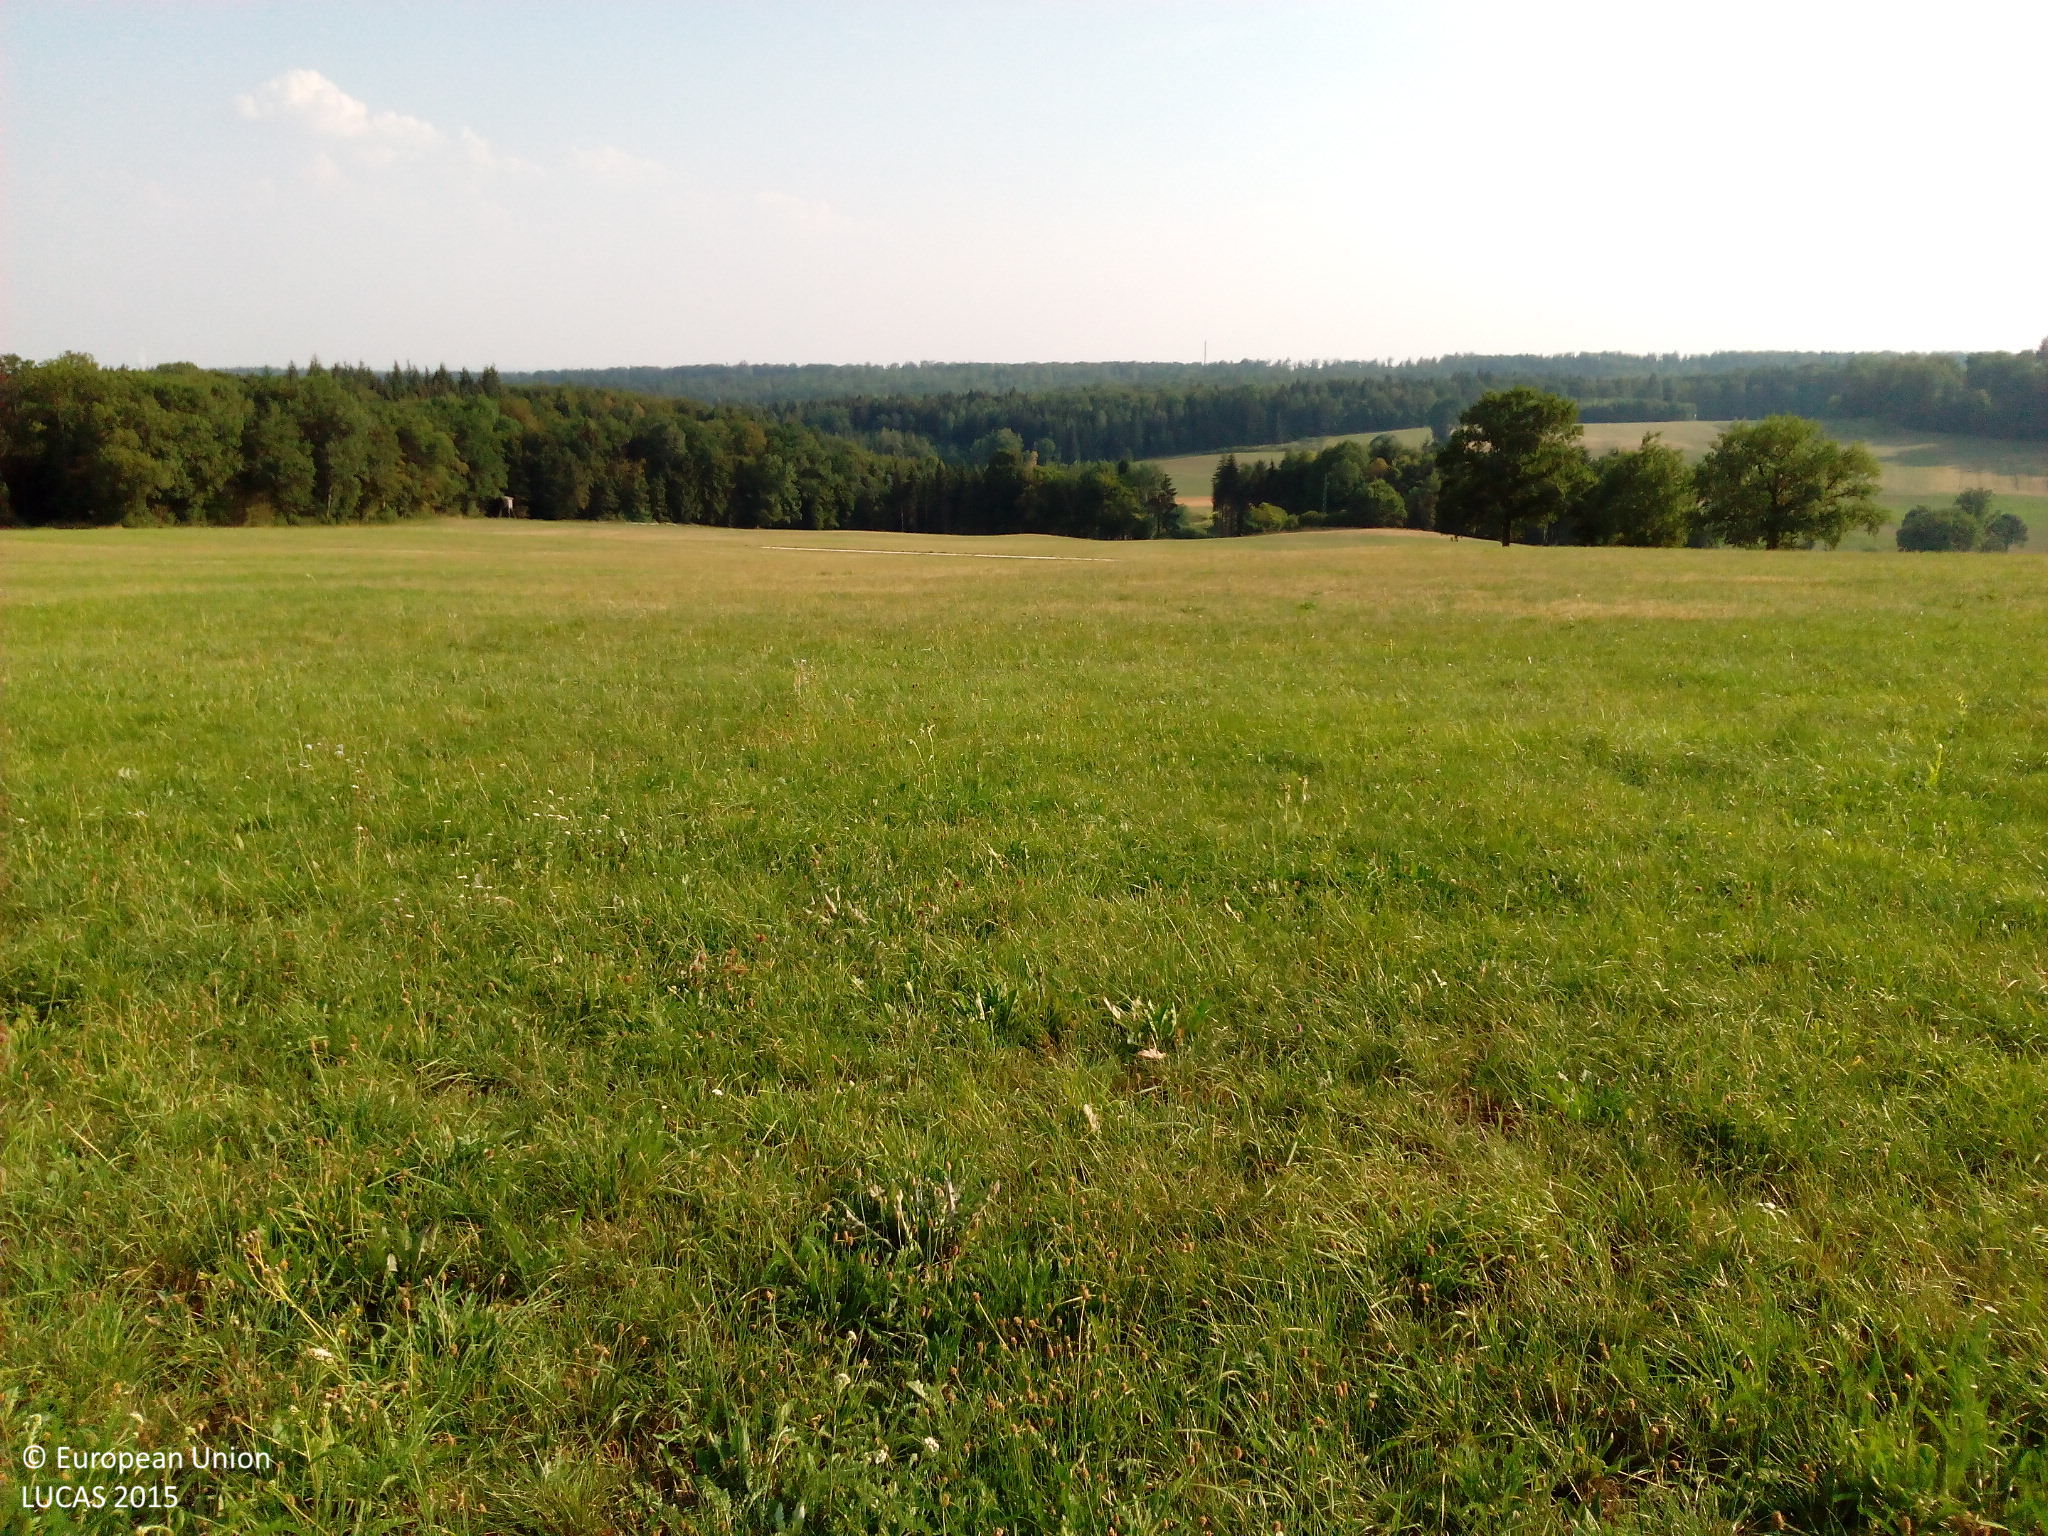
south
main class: Grassland
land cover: Grassland without tree/shrub cover
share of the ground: > 75 %
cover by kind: herbaceous plants 95 %, unconsolidated bare surface 5 %
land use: Agriculture (excluding fallow land and kitchen gardens)
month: August
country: DE
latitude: 48.6909
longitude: 10.3123
